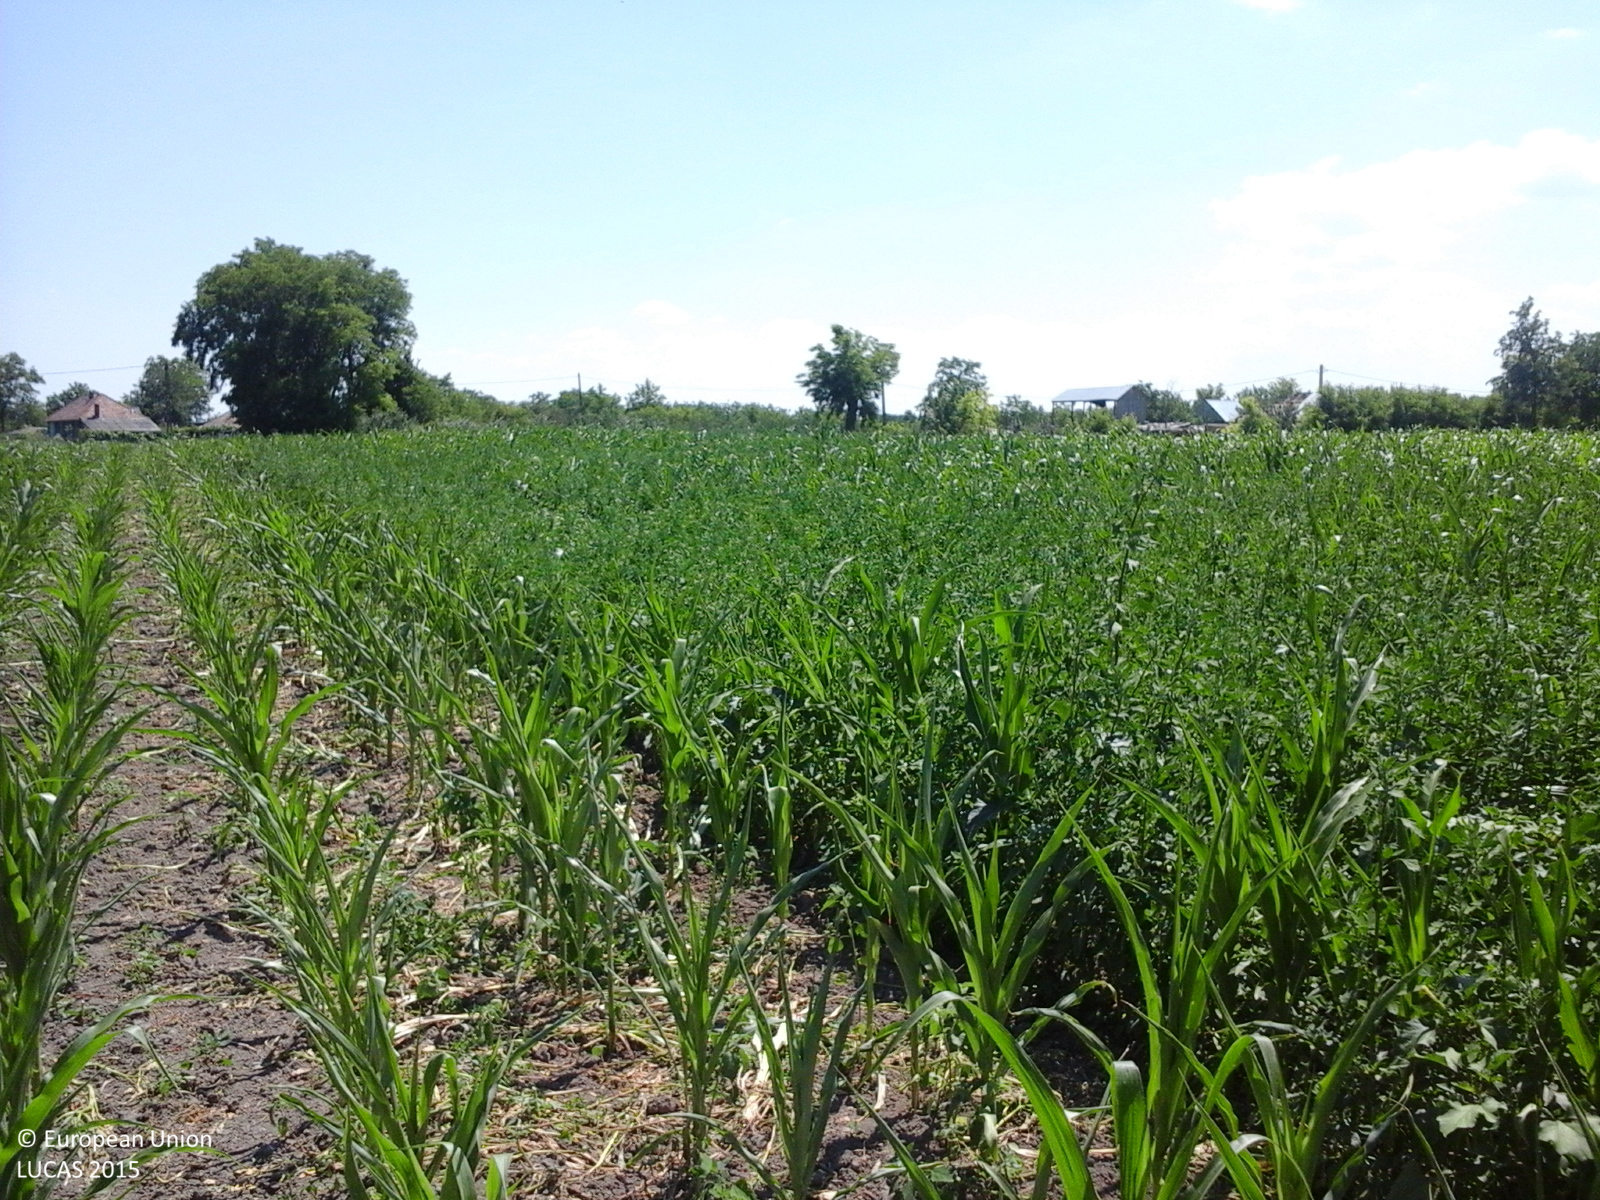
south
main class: Cropland
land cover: Maize
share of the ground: 25 - 50 %
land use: Agriculture (excluding fallow land and kitchen gardens)
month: June
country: RO
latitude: 47.4697
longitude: 27.5123
